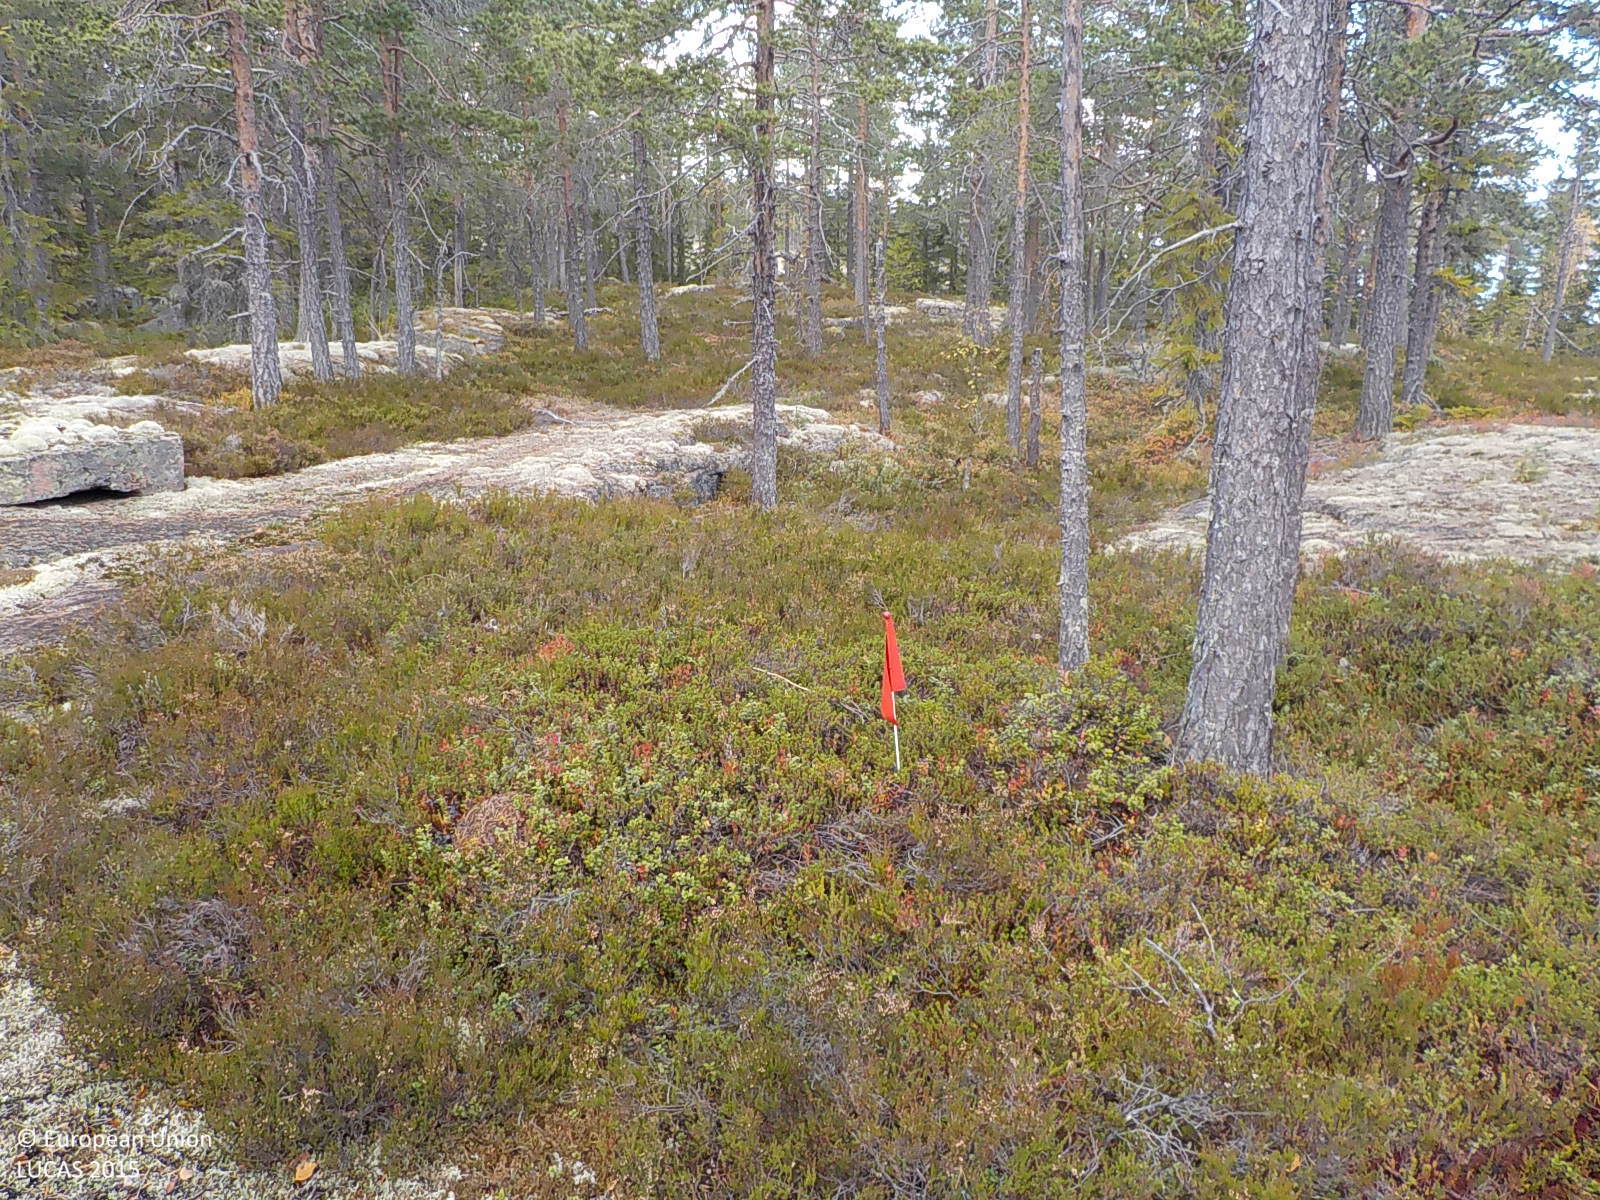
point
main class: Woodland
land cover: Pine dominated coniferous woodland
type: boreal forest
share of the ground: 10 - 25 %
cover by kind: shrubs 50 %, coniferous forest trees 20 %, lichens and mosses 15 %, consolidated bare surface 15 %
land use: Semi-natural and natural areas not in use
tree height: > 5 m
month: October
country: SE
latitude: 62.9921
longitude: 18.4472
